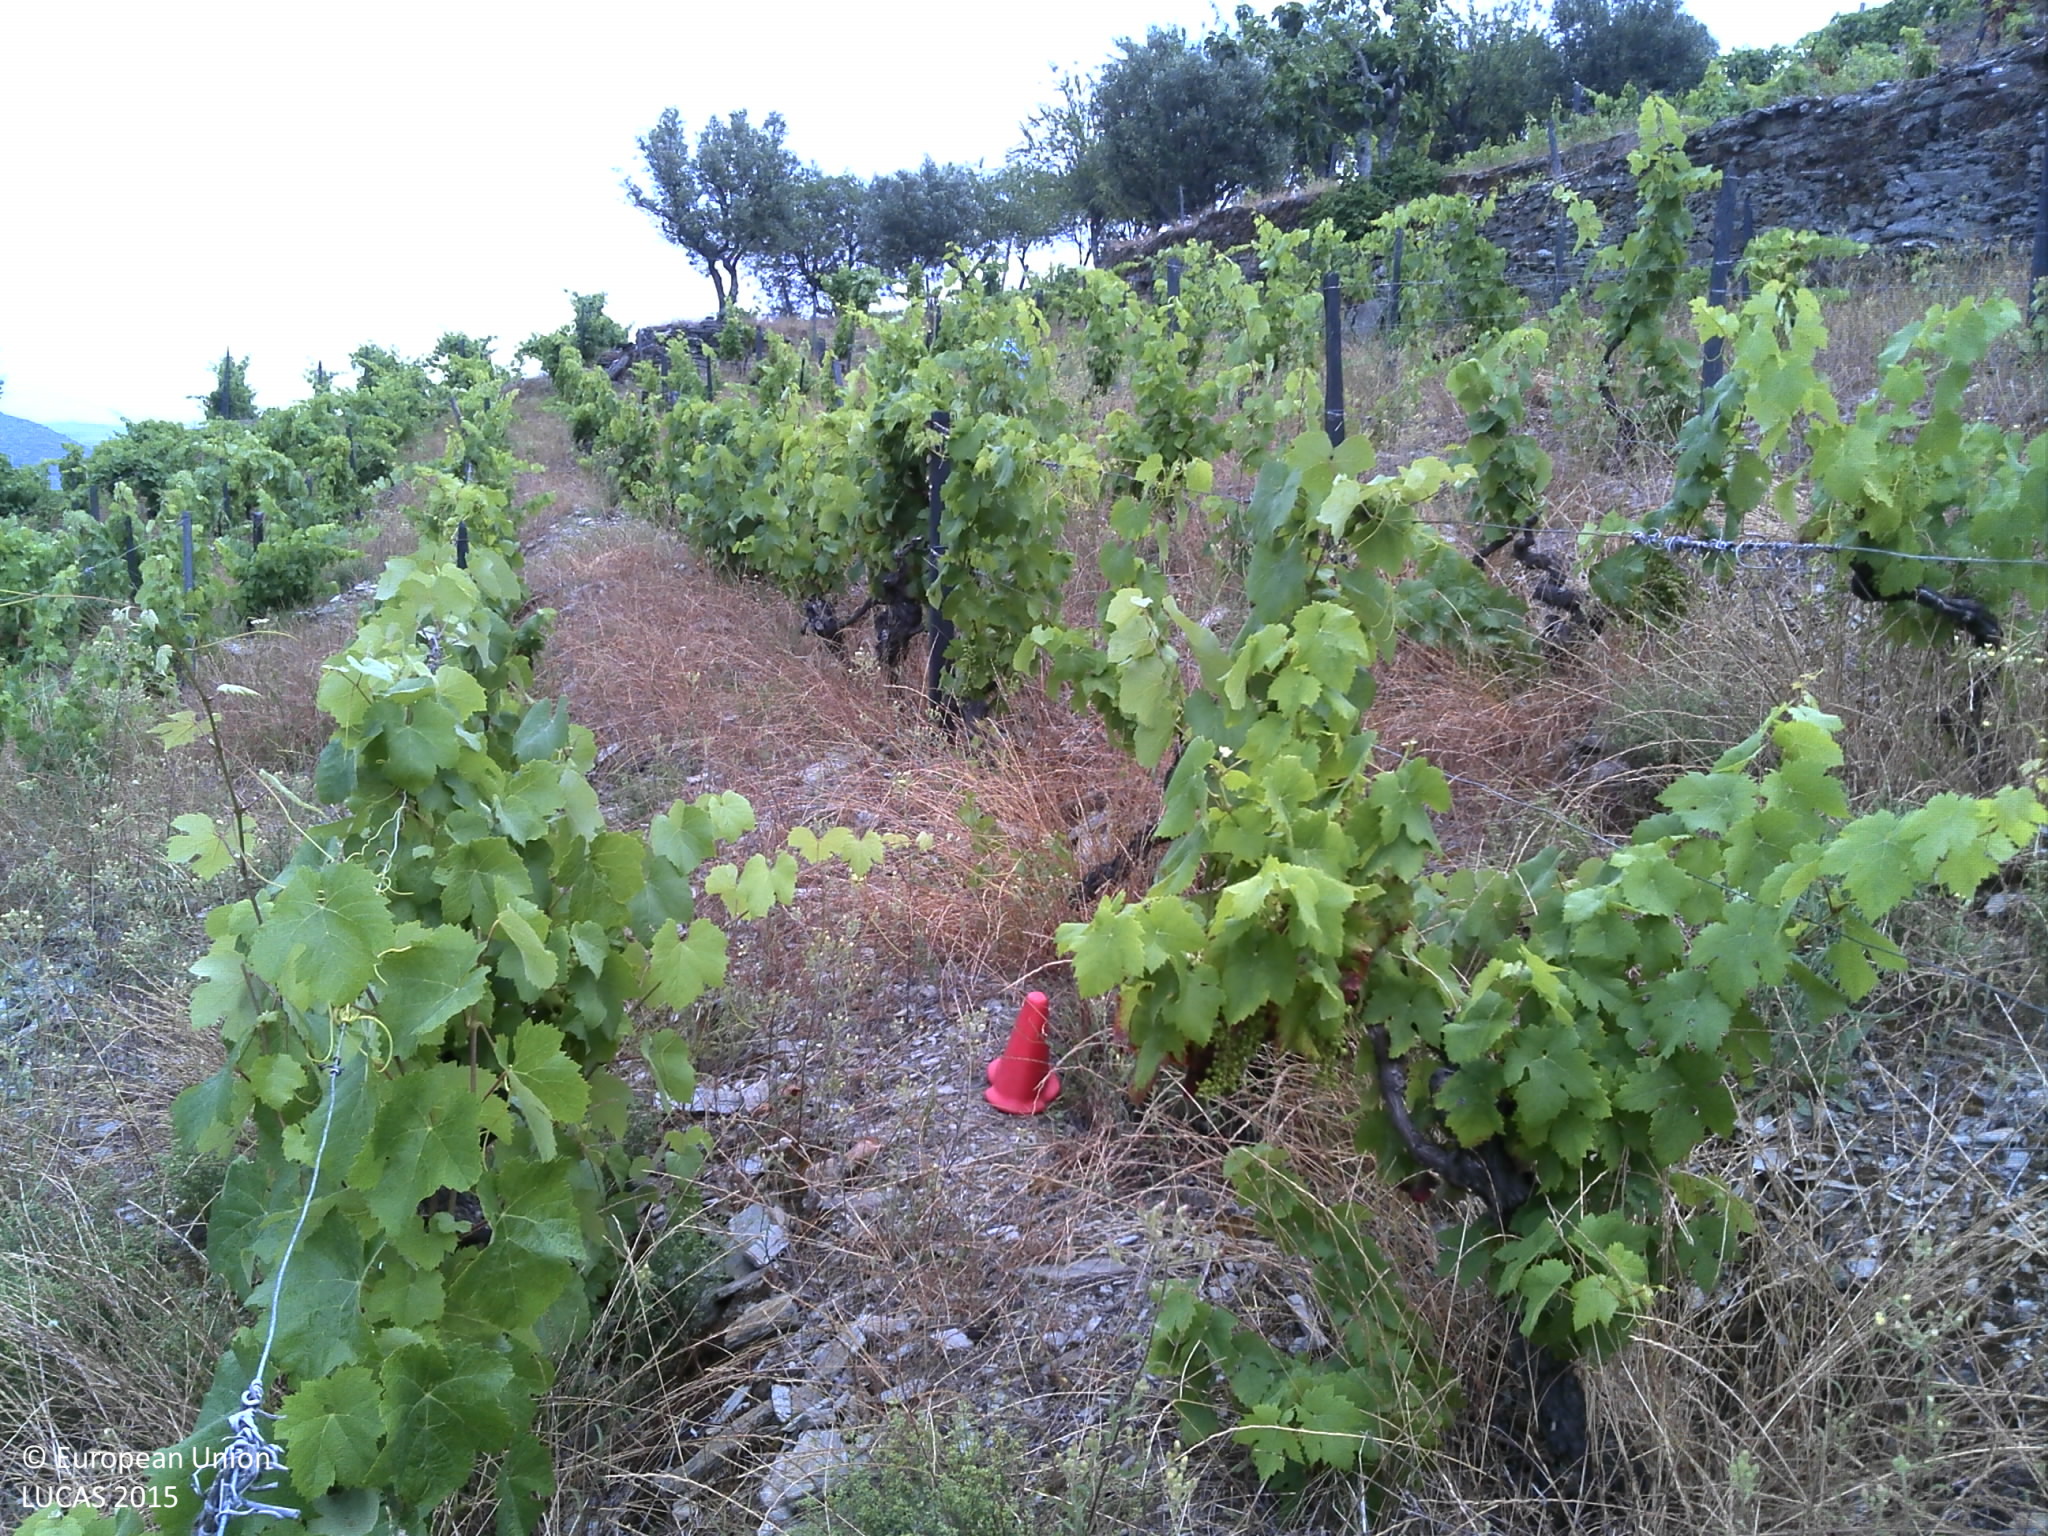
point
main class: Cropland
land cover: Vineyards
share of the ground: < 10 %
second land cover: Spontaneously vegetated surfaces
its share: 50 - 75 %
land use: Agriculture (excluding fallow land and kitchen gardens)
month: June
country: PT
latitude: 41.1612
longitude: -7.5588
